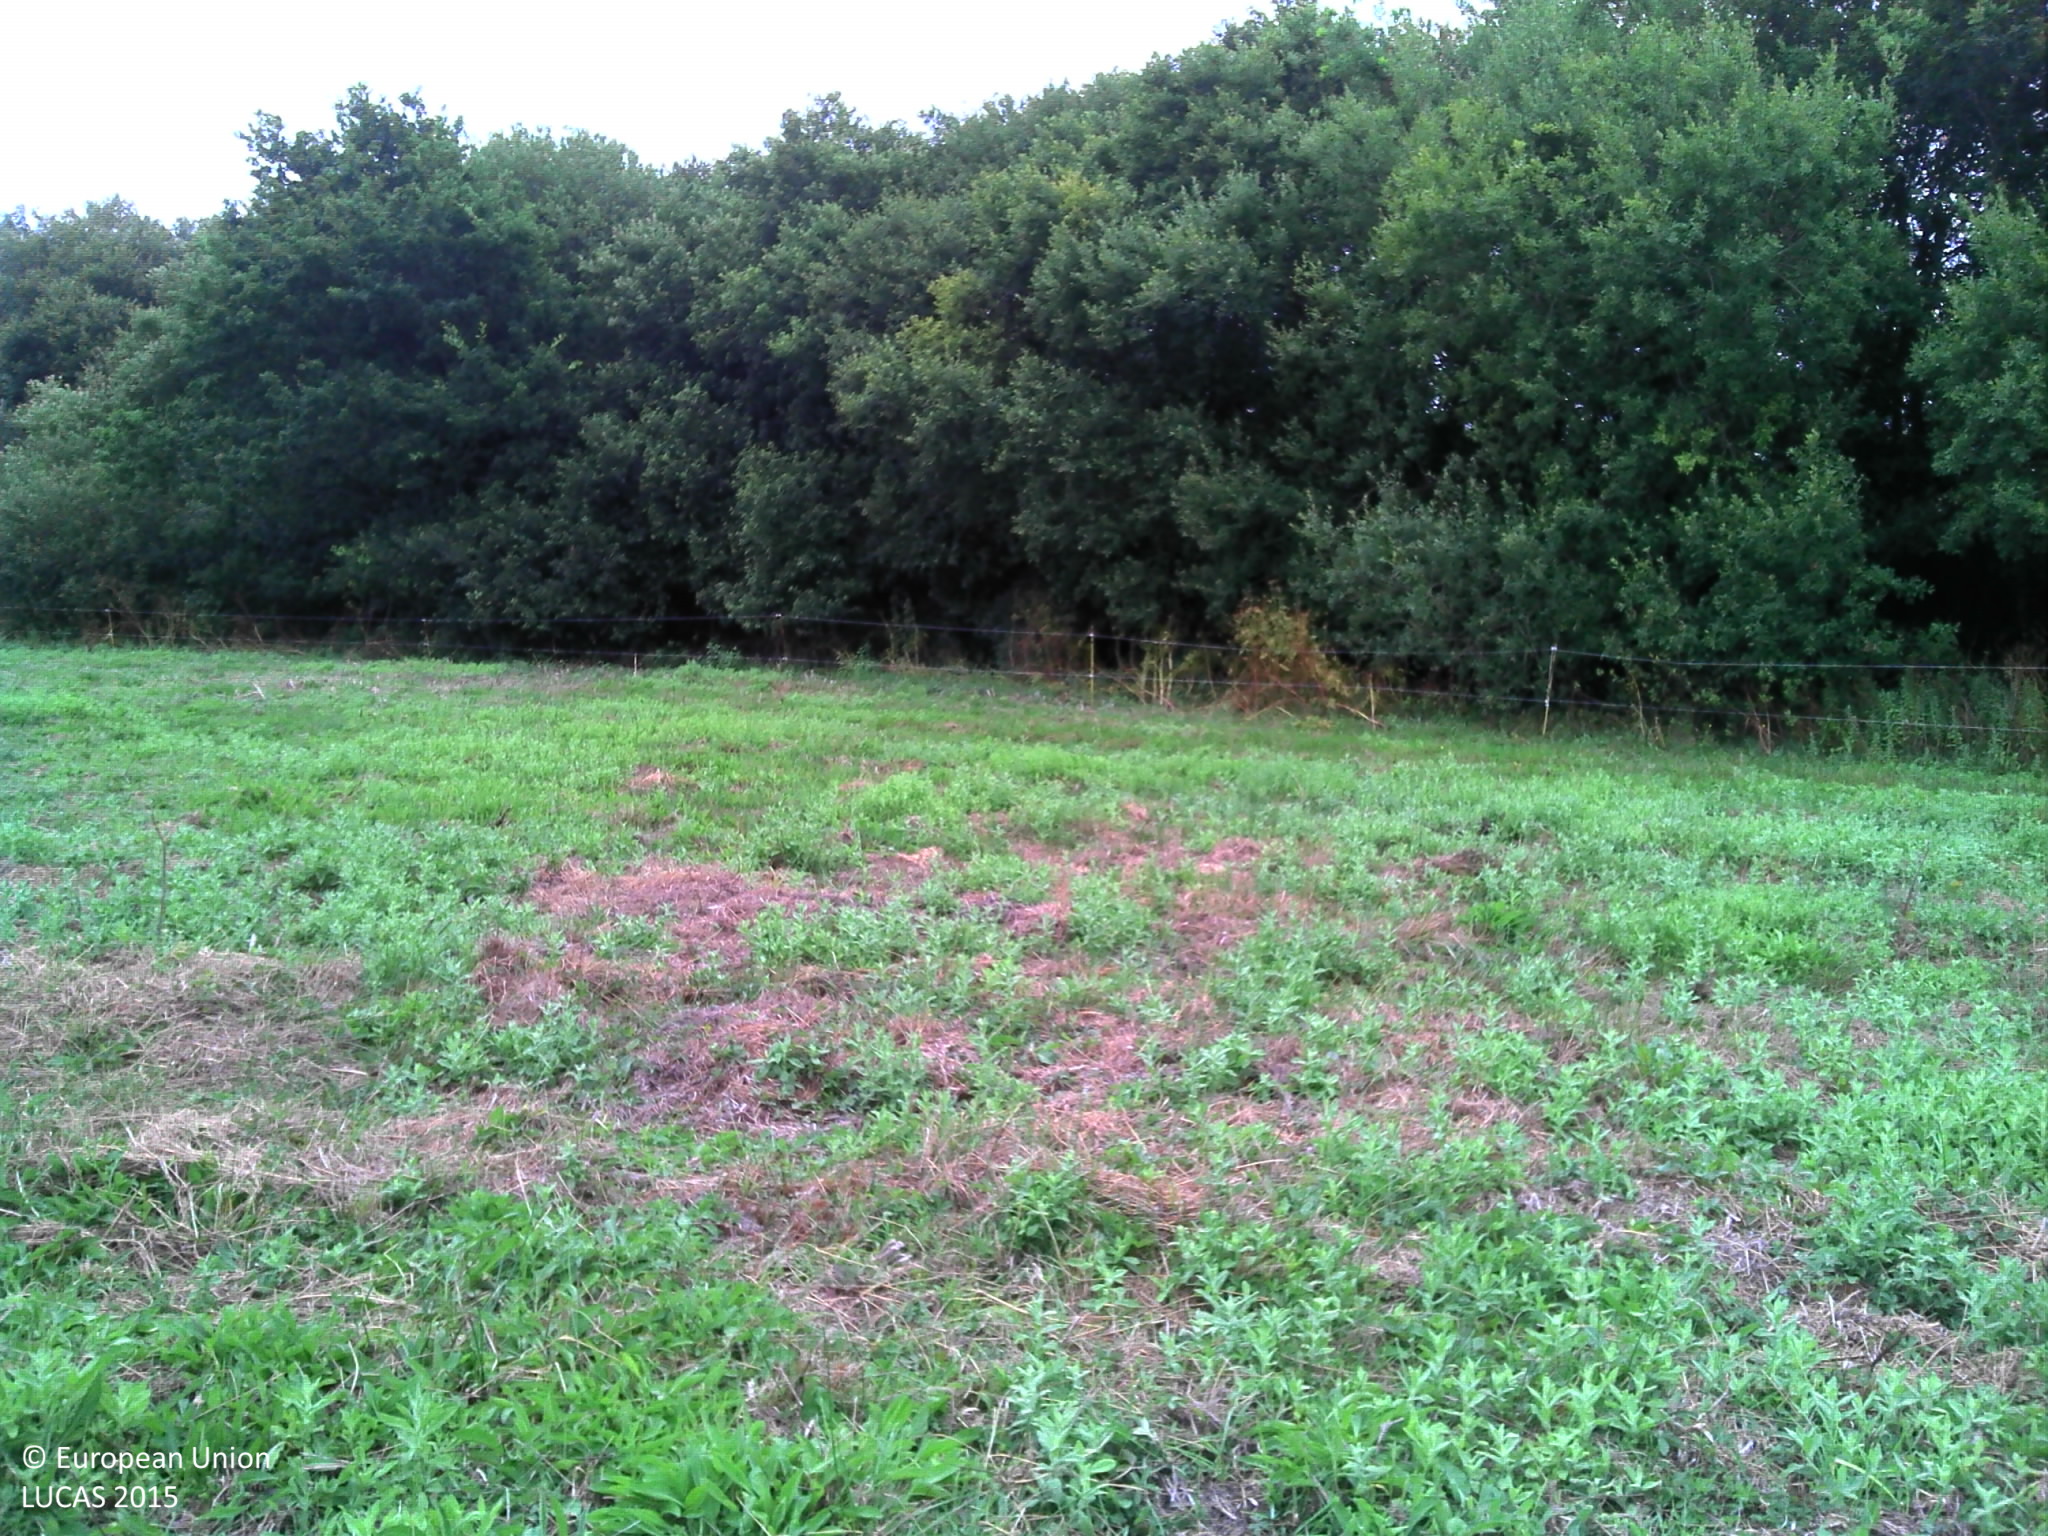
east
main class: Grassland
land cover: Spontaneously vegetated surfaces
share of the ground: > 75 %
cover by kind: herbaceous plants 90 %, unconsolidated bare surface 10 %
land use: Agriculture (excluding fallow land and kitchen gardens)
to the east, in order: Spontaneously vegetated surfaces; Fences; Broadleaved woodland; Spontaneously vegetated surfaces; Managed hedges; Spontaneously vegetated surfaces; Paved roads, cycling and walking lanes; Grass margins; Ditches and canals; Spontaneously vegetated surfaces; Broadleaved woodland
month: July
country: FR
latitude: 47.6787
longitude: -3.2170
